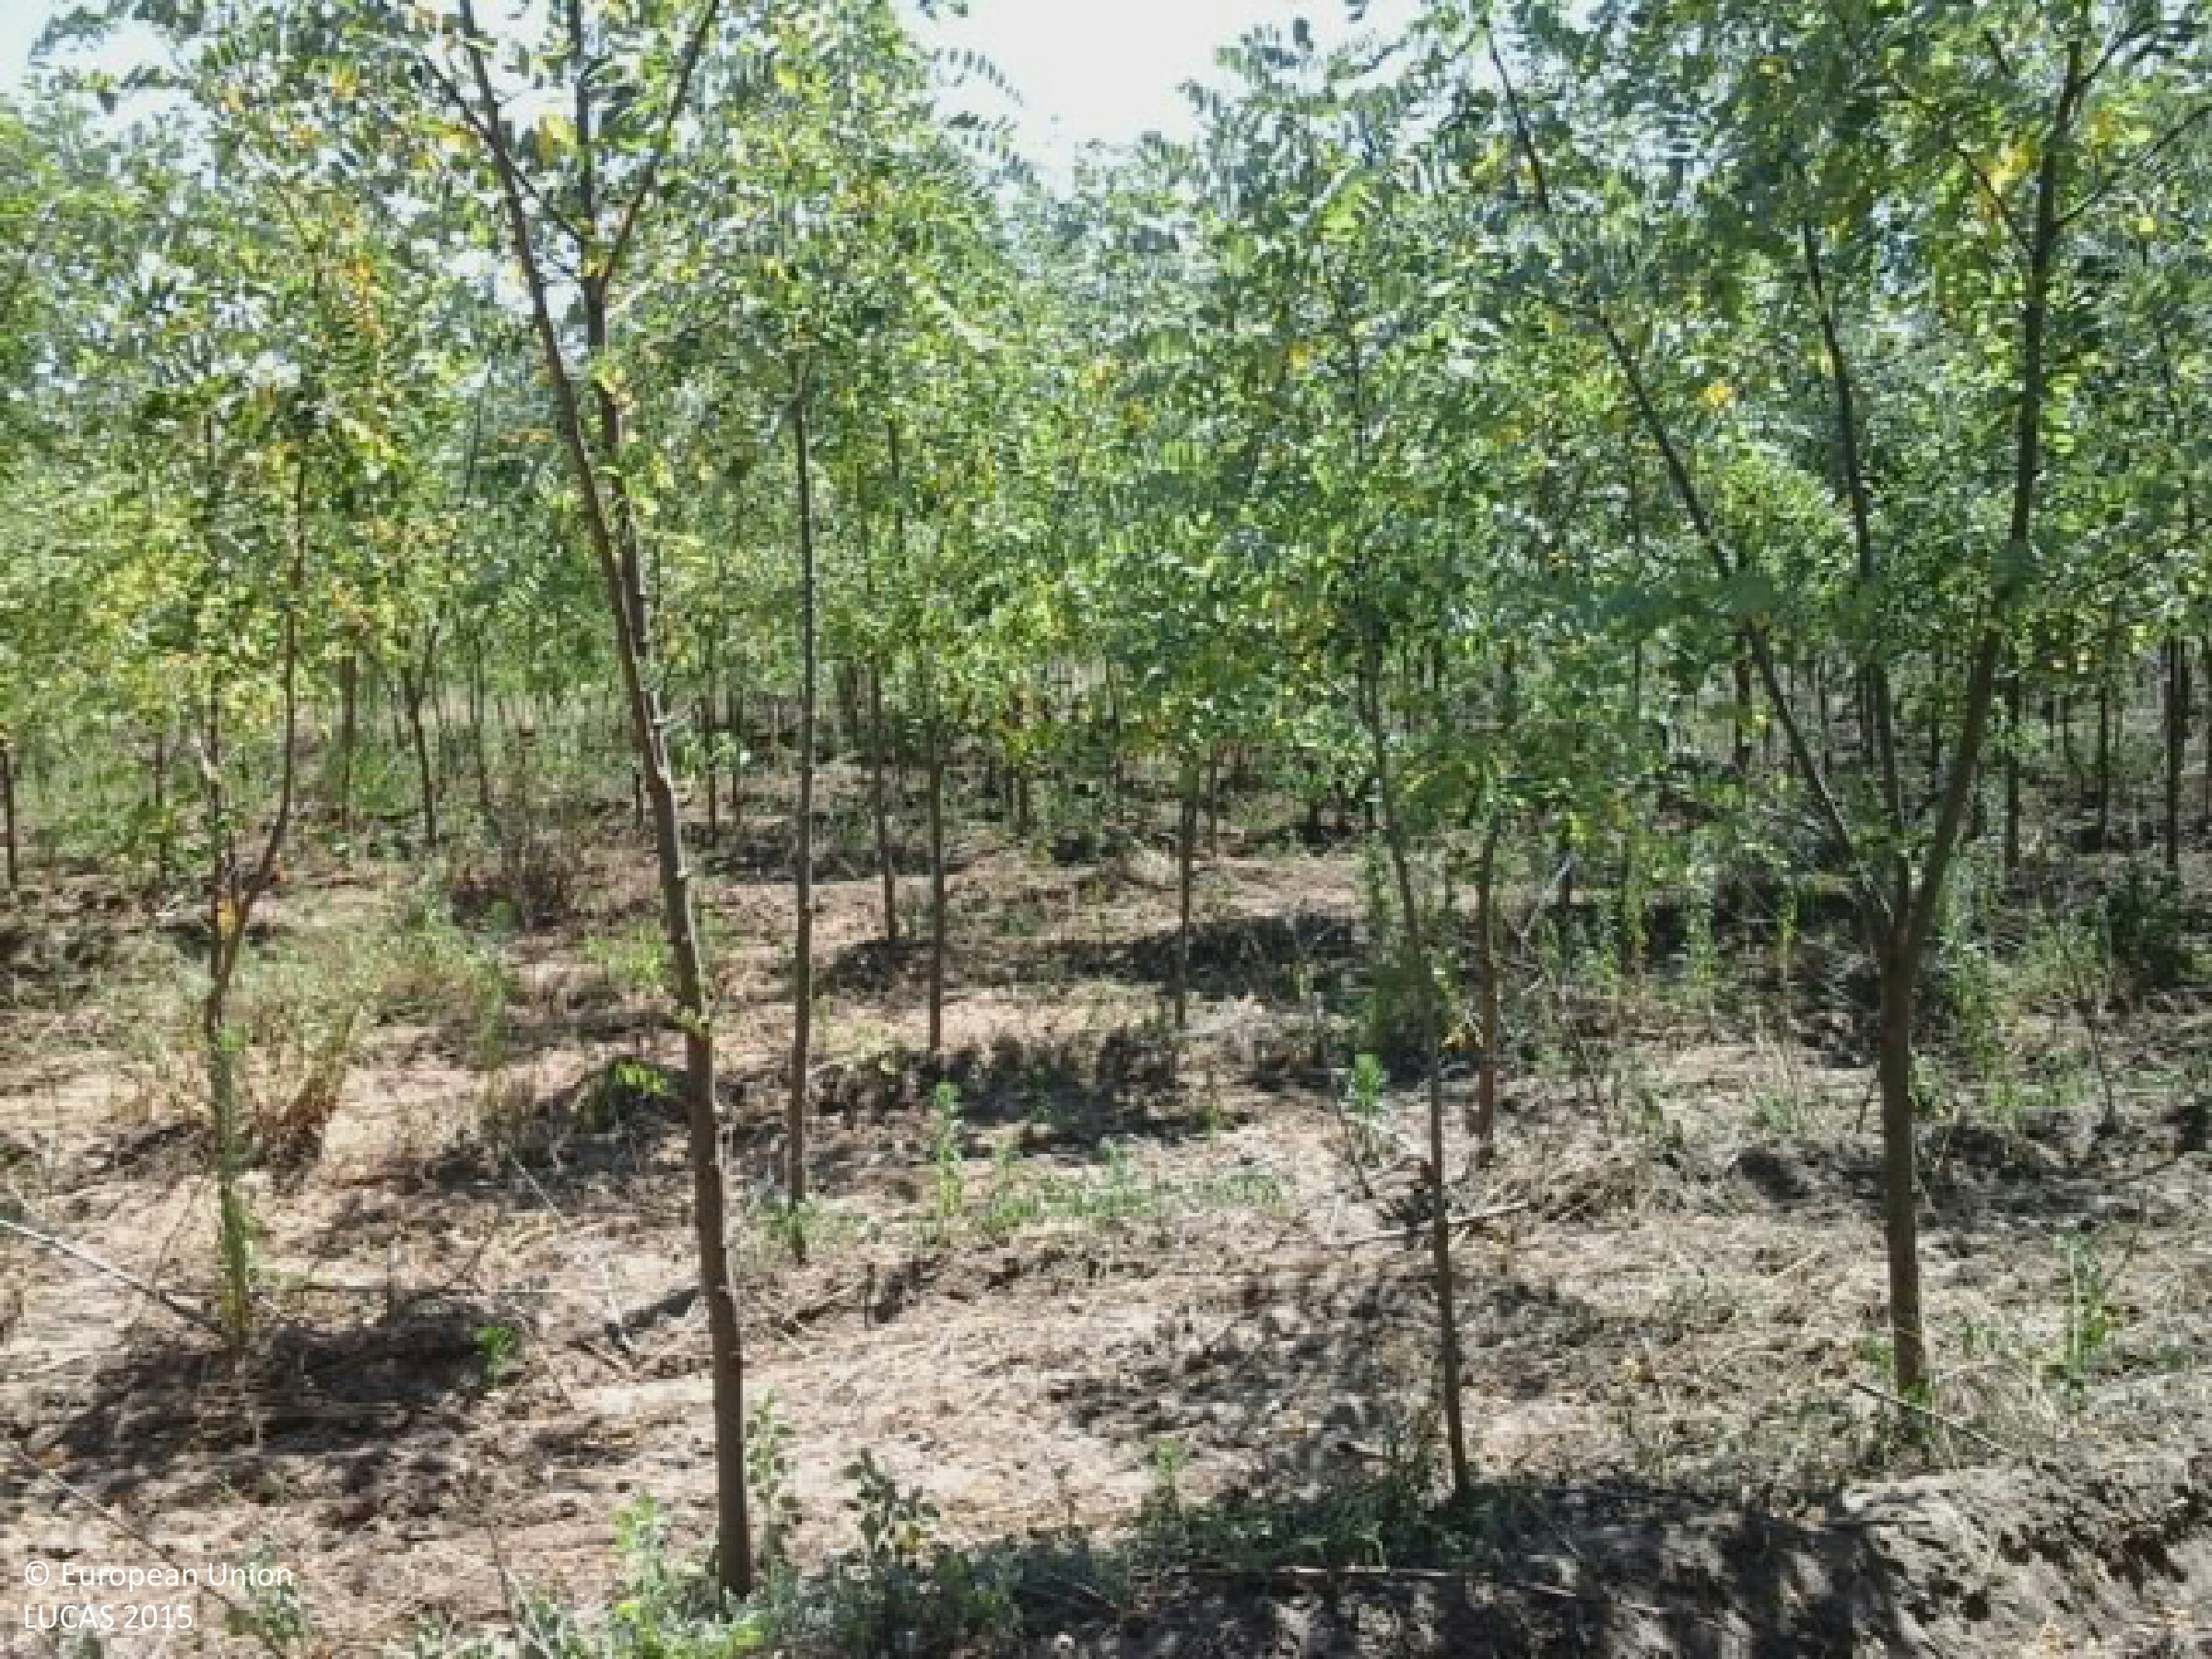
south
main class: Woodland
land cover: Broadleaved woodland
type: exotic forest
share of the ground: 50 - 75 %
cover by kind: broadleaved forest trees 70 %, herbaceous plants 15 %, unconsolidated bare surface 15 %
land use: Forestry
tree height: < 5 m
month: July
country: HU
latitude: 47.2896
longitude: 19.2613
